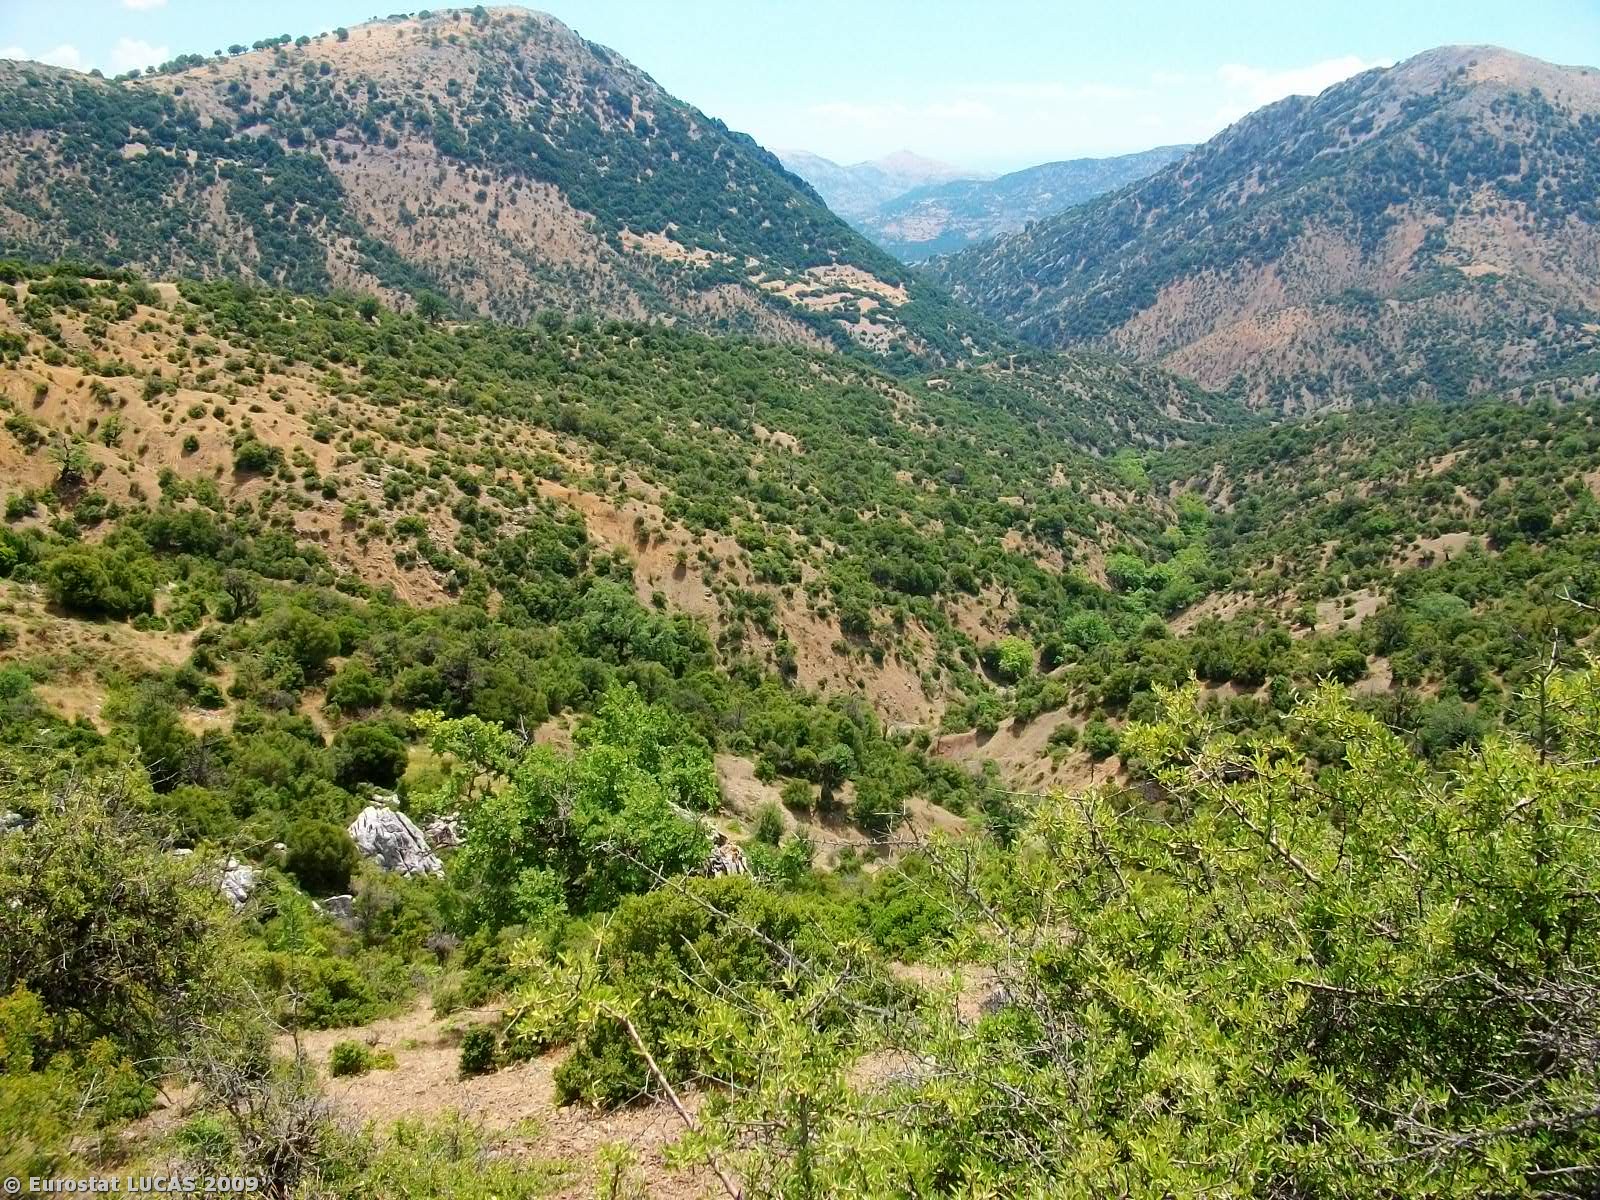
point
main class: Shrubland
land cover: Shrubland with sparse tree cover
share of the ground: 50 - 75 %
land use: Agriculture (excluding fallow land and kitchen gardens)
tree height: < 5 m
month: July
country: GR
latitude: 38.4660
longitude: 22.1560
